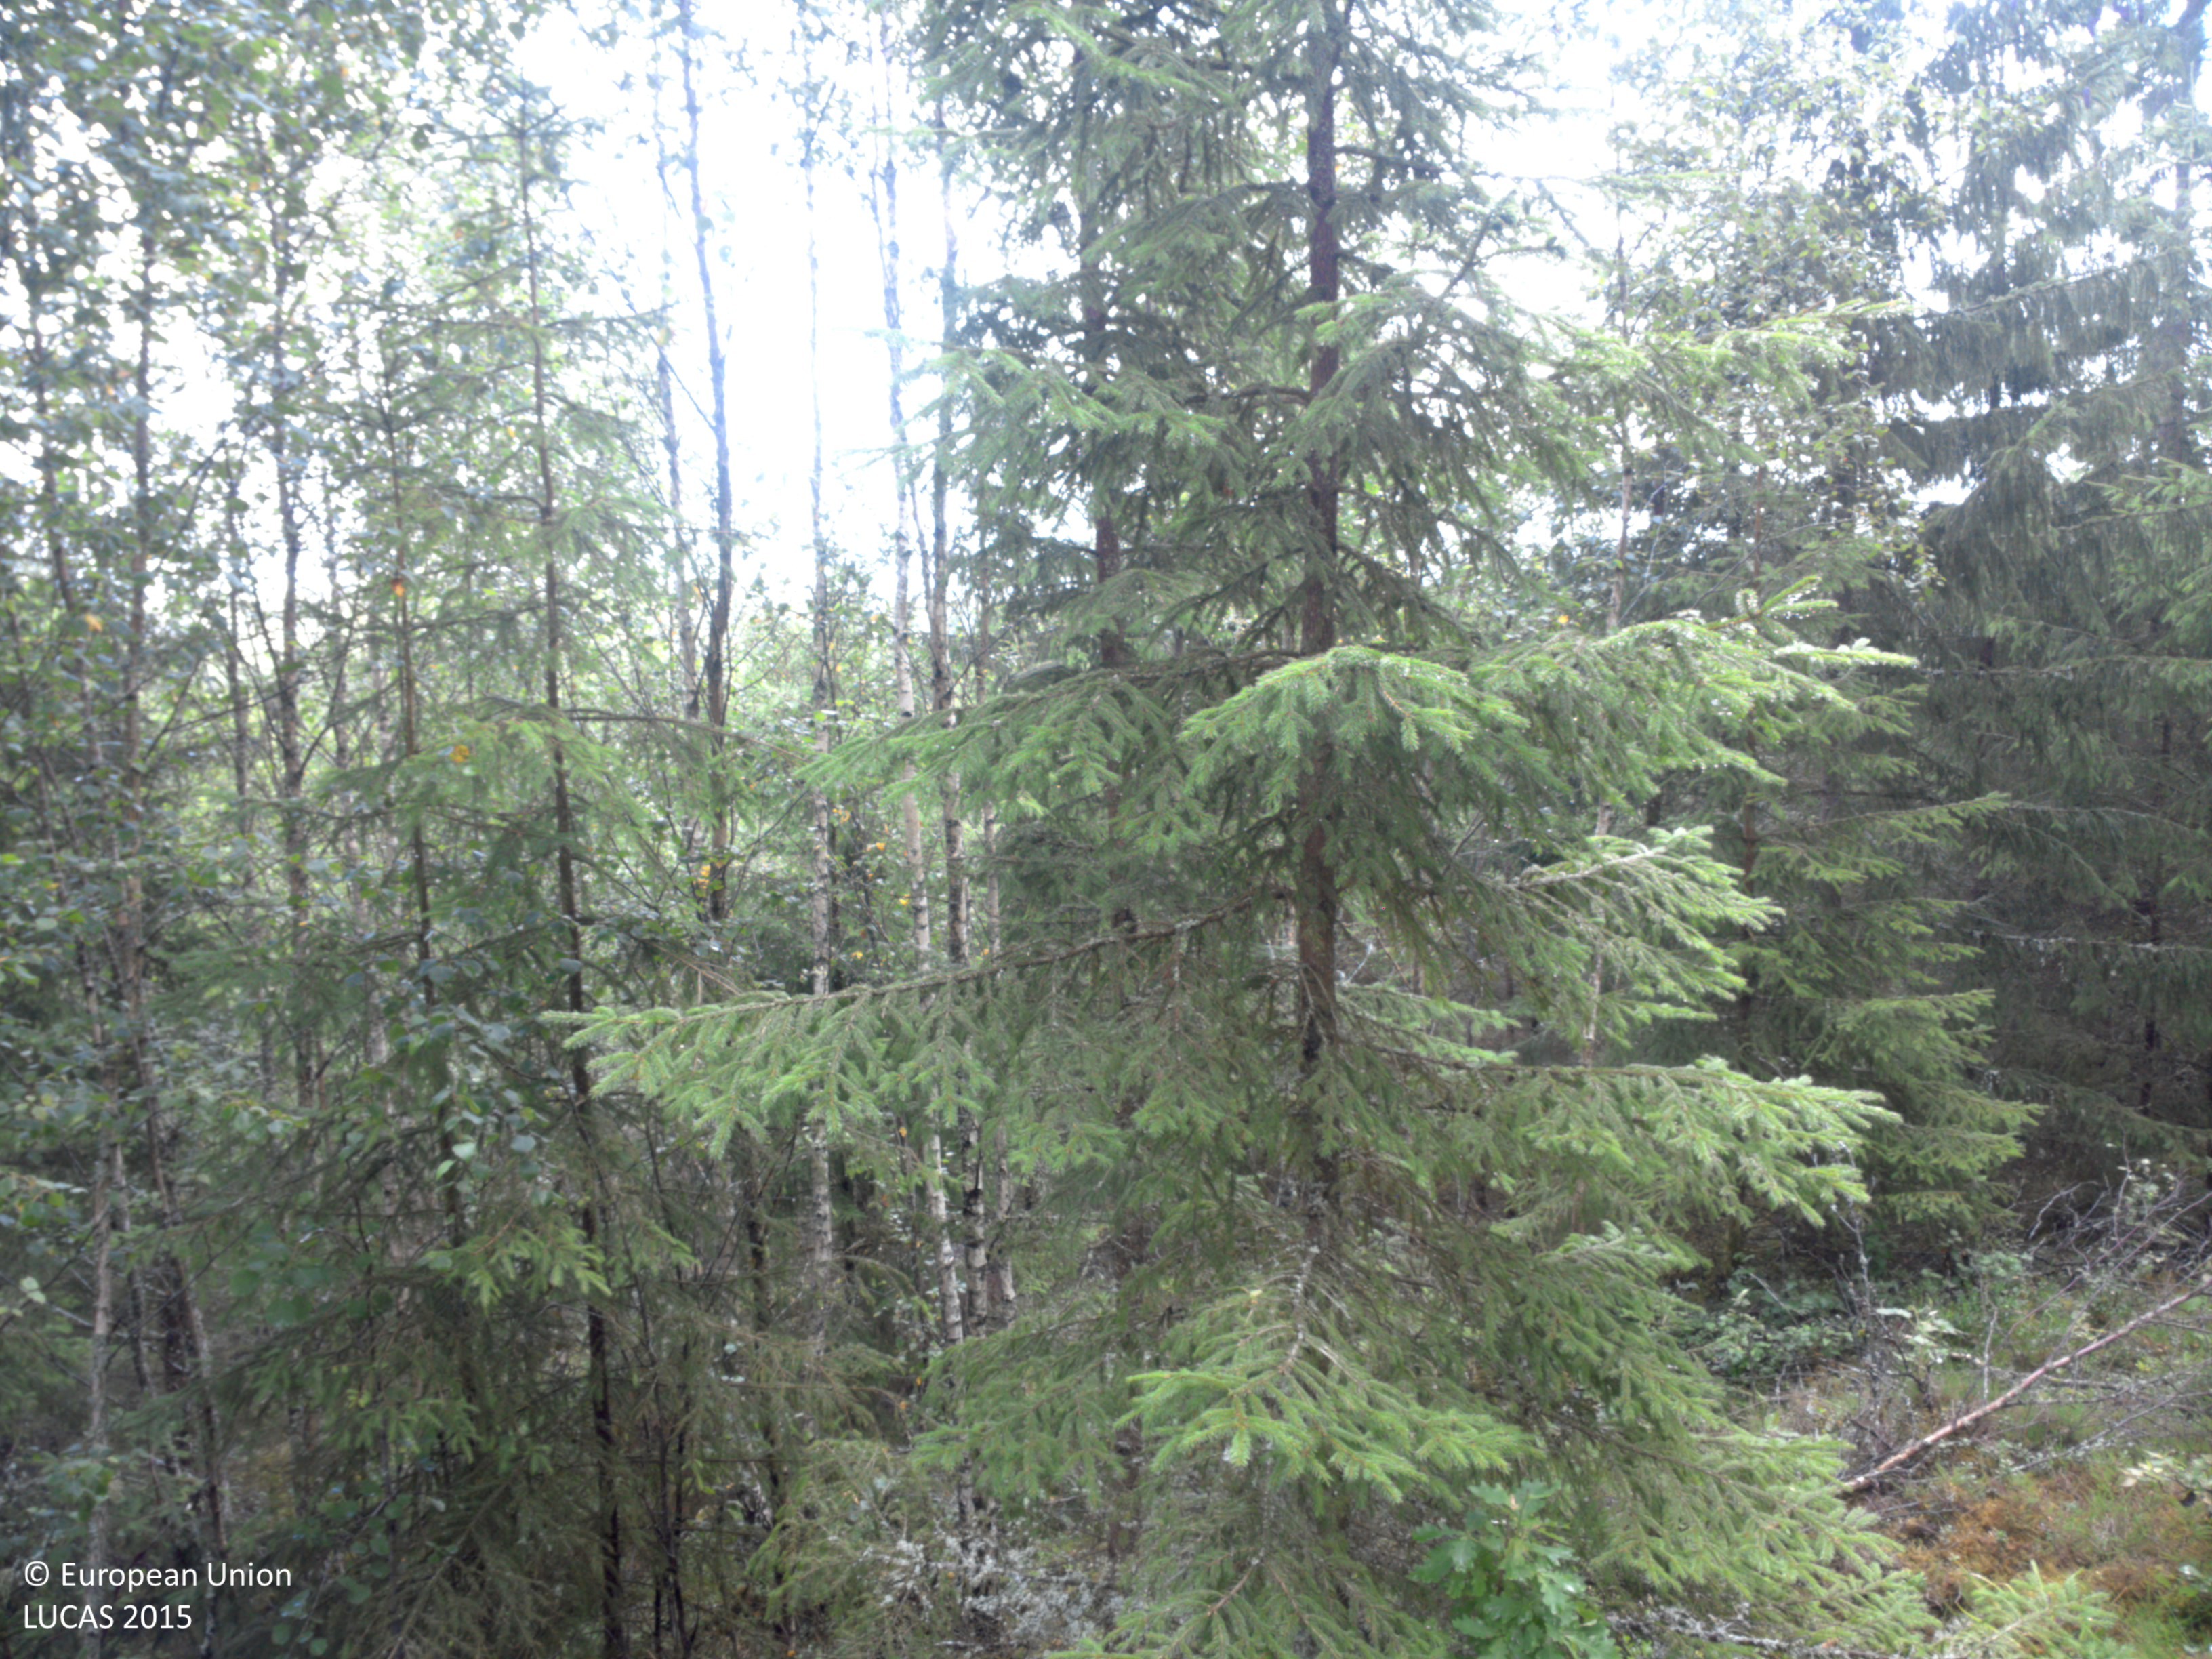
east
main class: Woodland
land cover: Spruce dominated mixed woodland
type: boreal forest
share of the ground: 50 - 75 %
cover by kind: coniferous forest trees 40 %, herbaceous plants 30 %, broadleaved forest trees 20 %, lichens and mosses 10 %
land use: Forestry
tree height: > 5 m
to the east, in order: Spruce dominated mixed woodland; Spruce dominated coniferous woodland; Broadleaved woodland; Ditches and canals; Spruce dominated mixed woodland; Spruce dominated coniferous woodland; Tracks; Spruce dominated coniferous woodland
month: July
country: SE
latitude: 58.6373
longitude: 11.9424
